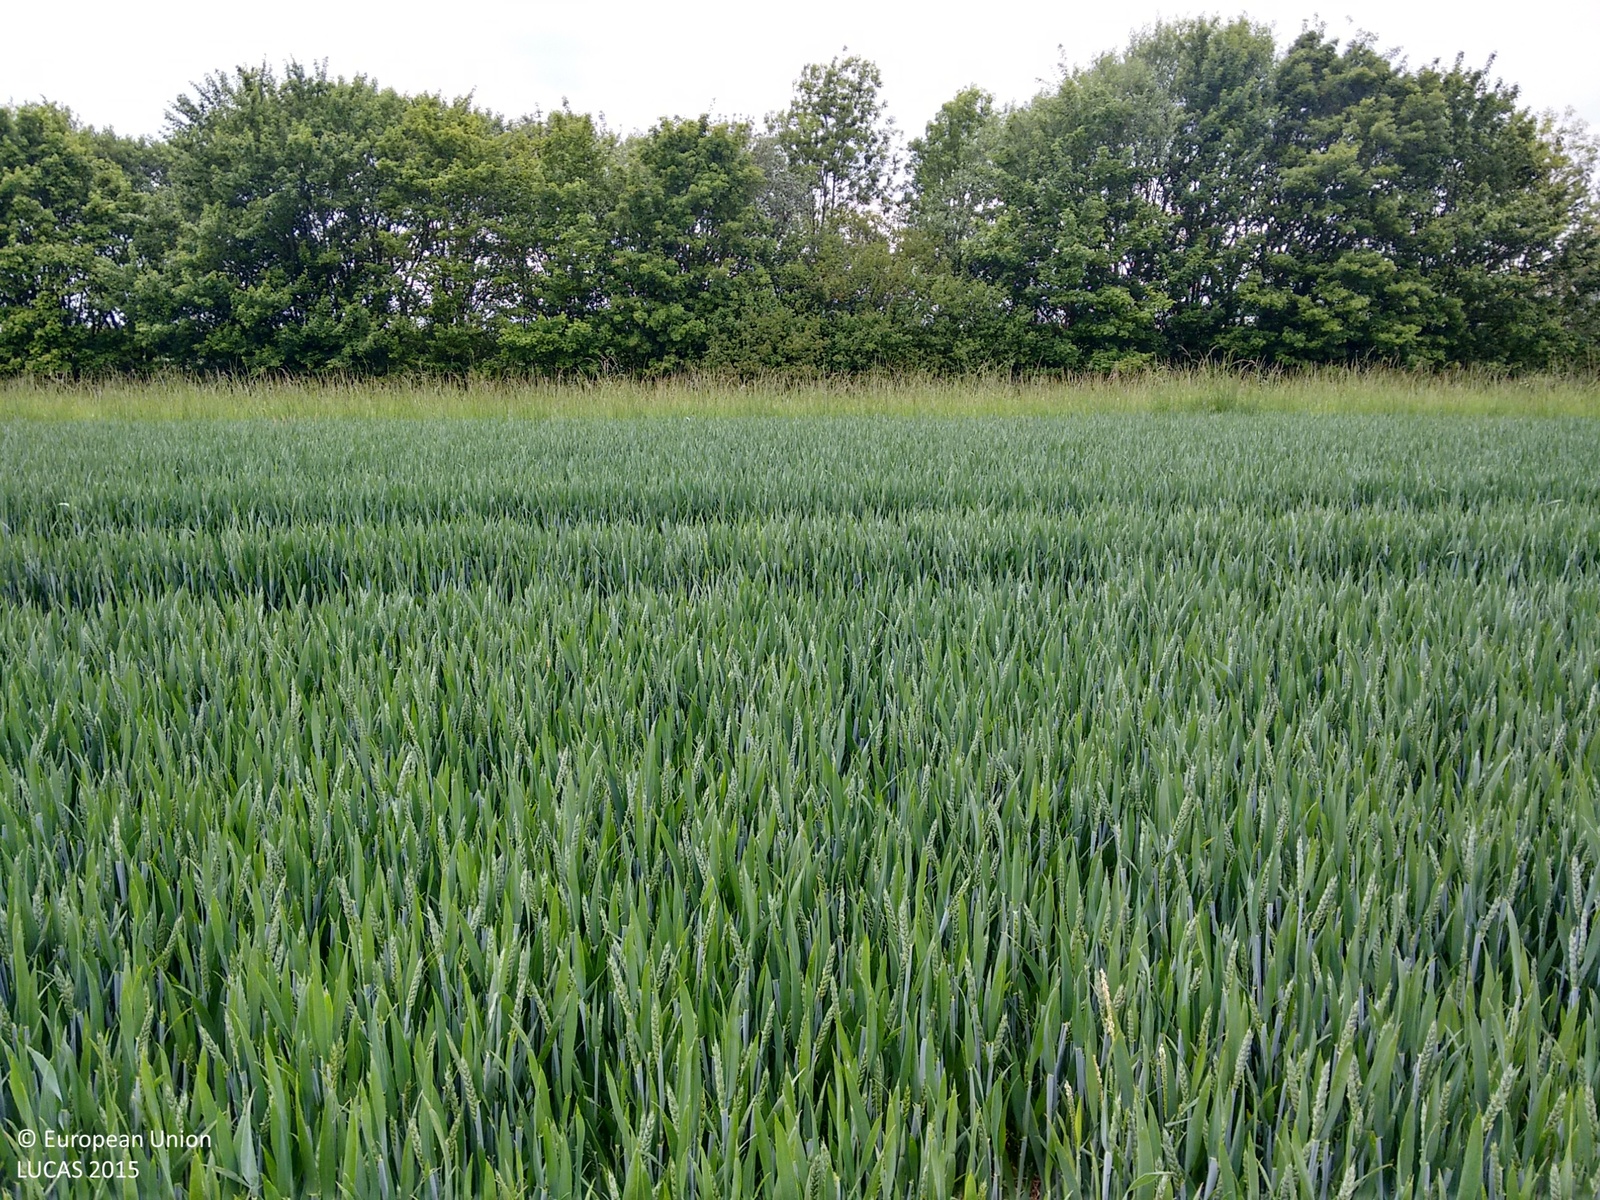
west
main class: Cropland
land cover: Common wheat
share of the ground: > 75 %
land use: Agriculture (excluding fallow land and kitchen gardens)
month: May
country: GB
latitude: 52.8835
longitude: -0.3644
